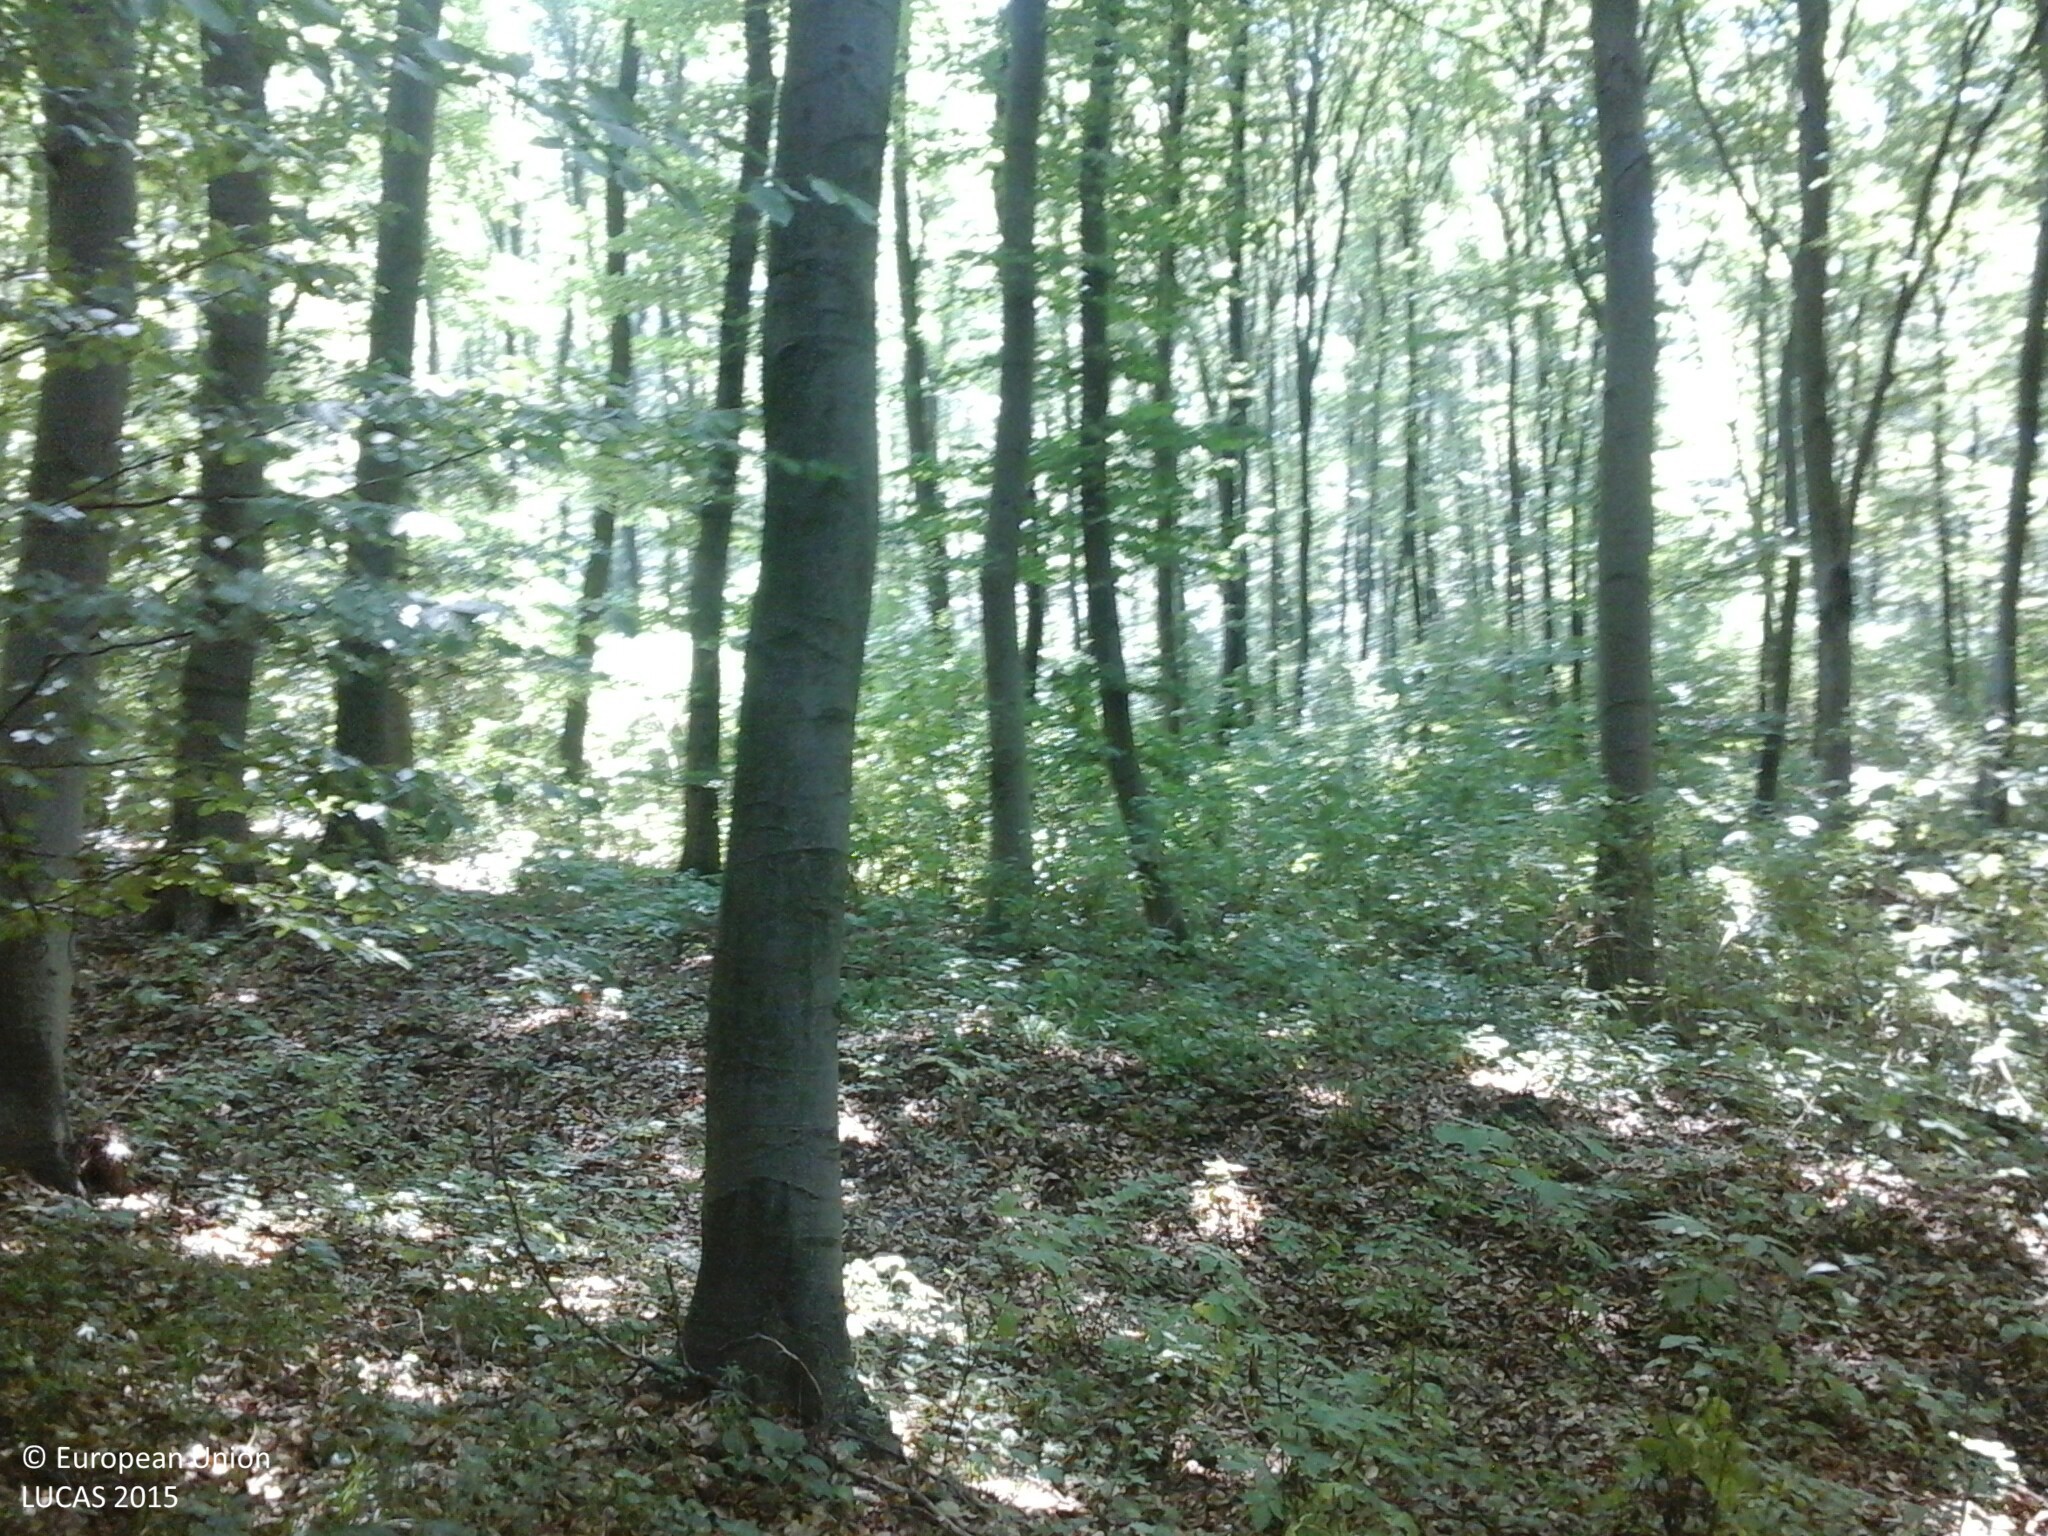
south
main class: Woodland
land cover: Broadleaved woodland
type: beech forest
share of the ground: > 75 %
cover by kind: broadleaved forest trees 100 %
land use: Forestry
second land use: Amenities, museums, leisure
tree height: > 5 m
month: August
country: HU
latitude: 47.3107
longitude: 18.0929
